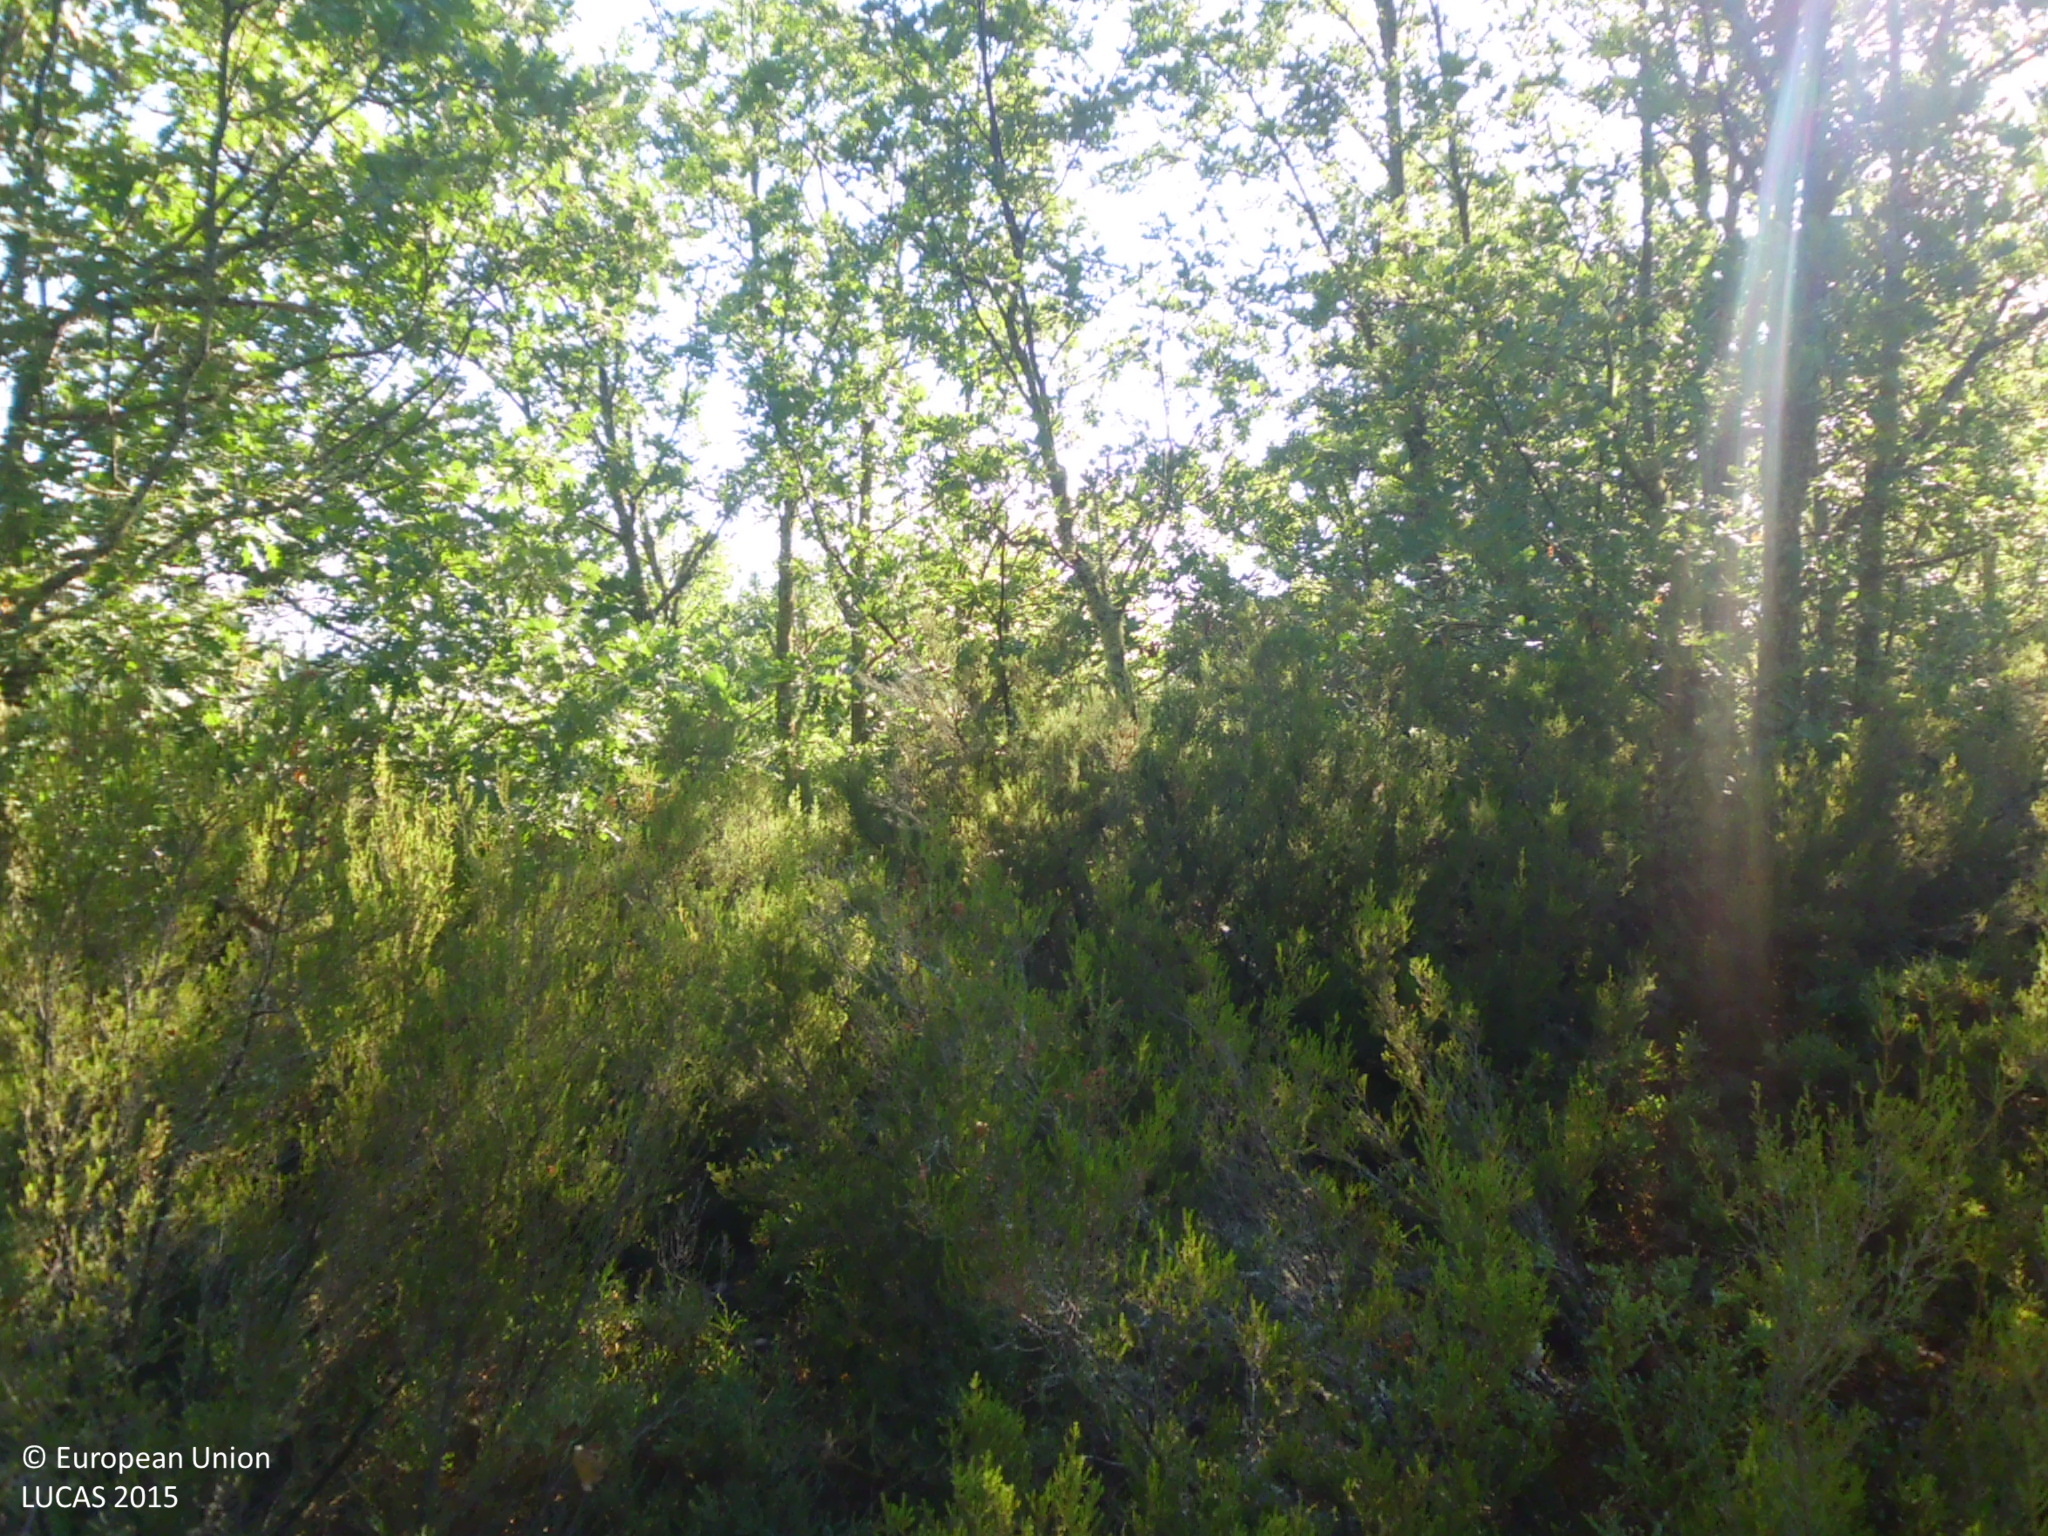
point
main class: Woodland
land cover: Broadleaved woodland
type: acidophilous oak and oak-birch forest
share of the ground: 50 - 75 %
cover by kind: broadleaved forest trees 50 %, shrubs 50 %
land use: Semi-natural and natural areas not in use
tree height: > 5 m
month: June
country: ES
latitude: 42.6793
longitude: -5.0366
